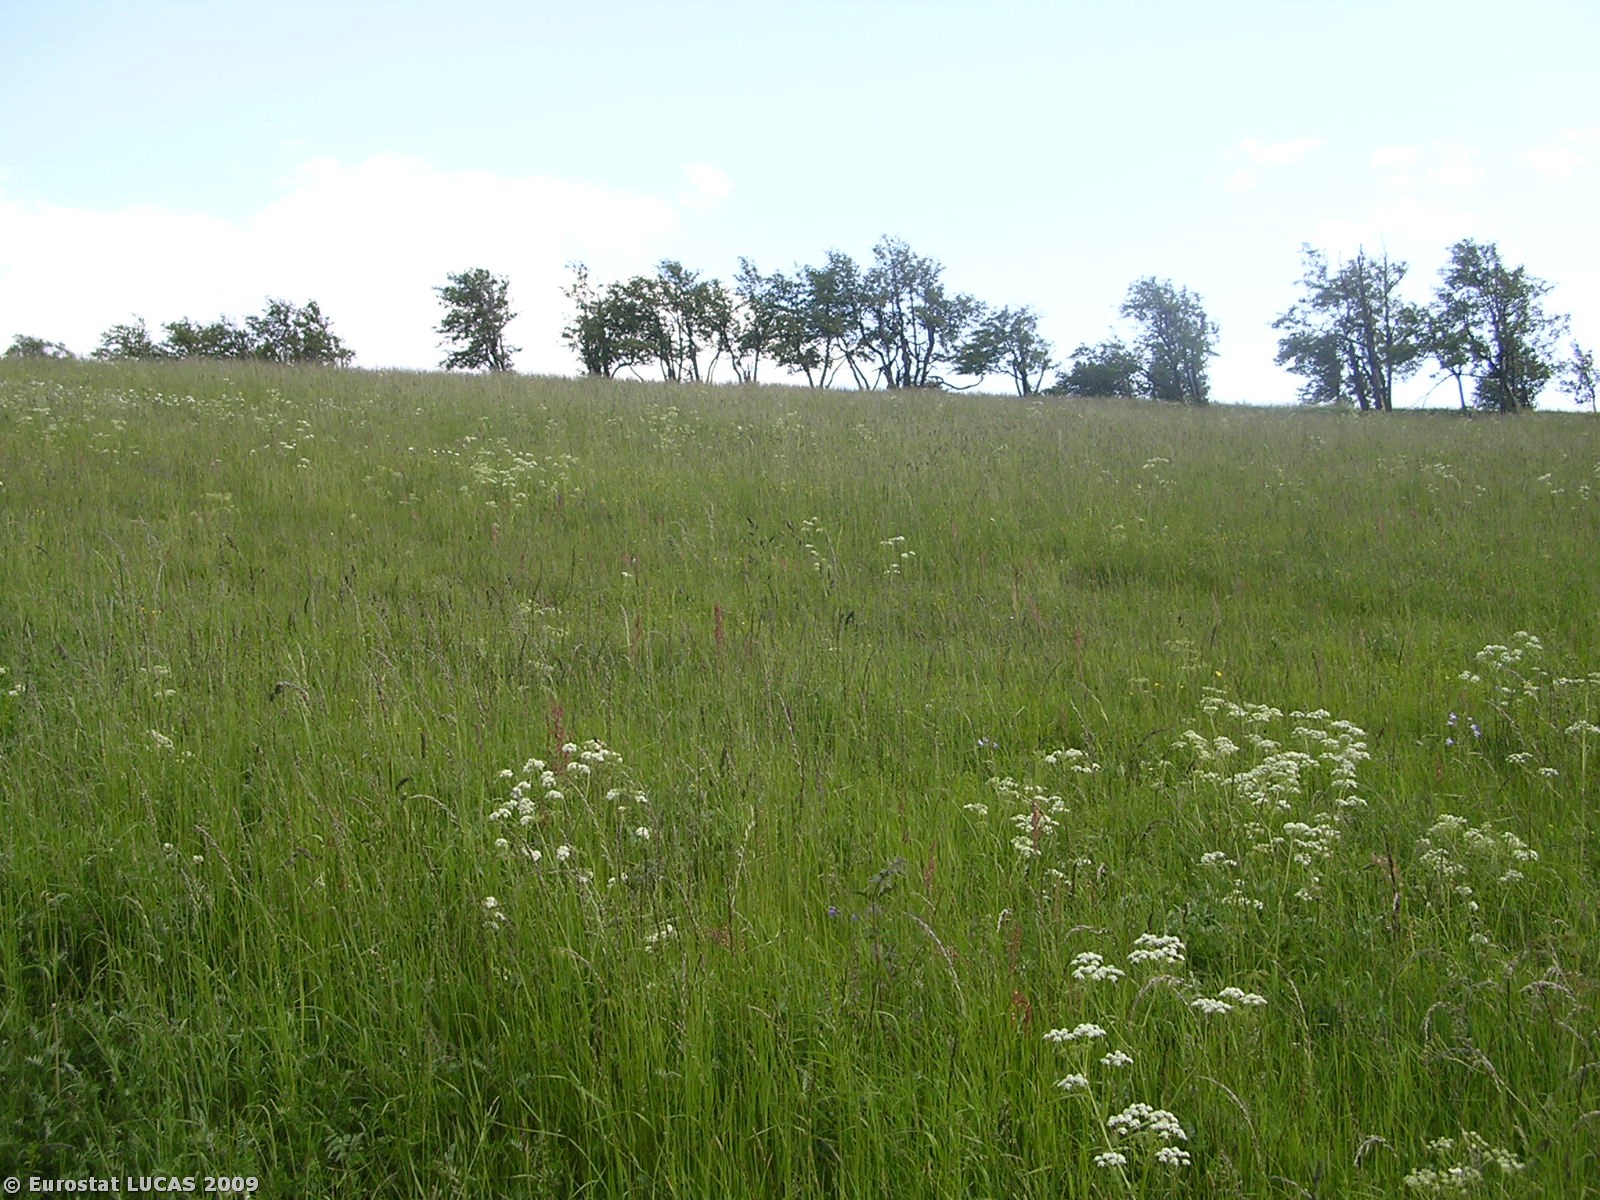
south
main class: Grassland
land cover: Grassland without tree/shrub cover
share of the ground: > 75 %
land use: Agriculture (excluding fallow land and kitchen gardens)
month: June
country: CZ
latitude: 50.7448
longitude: 13.9833
